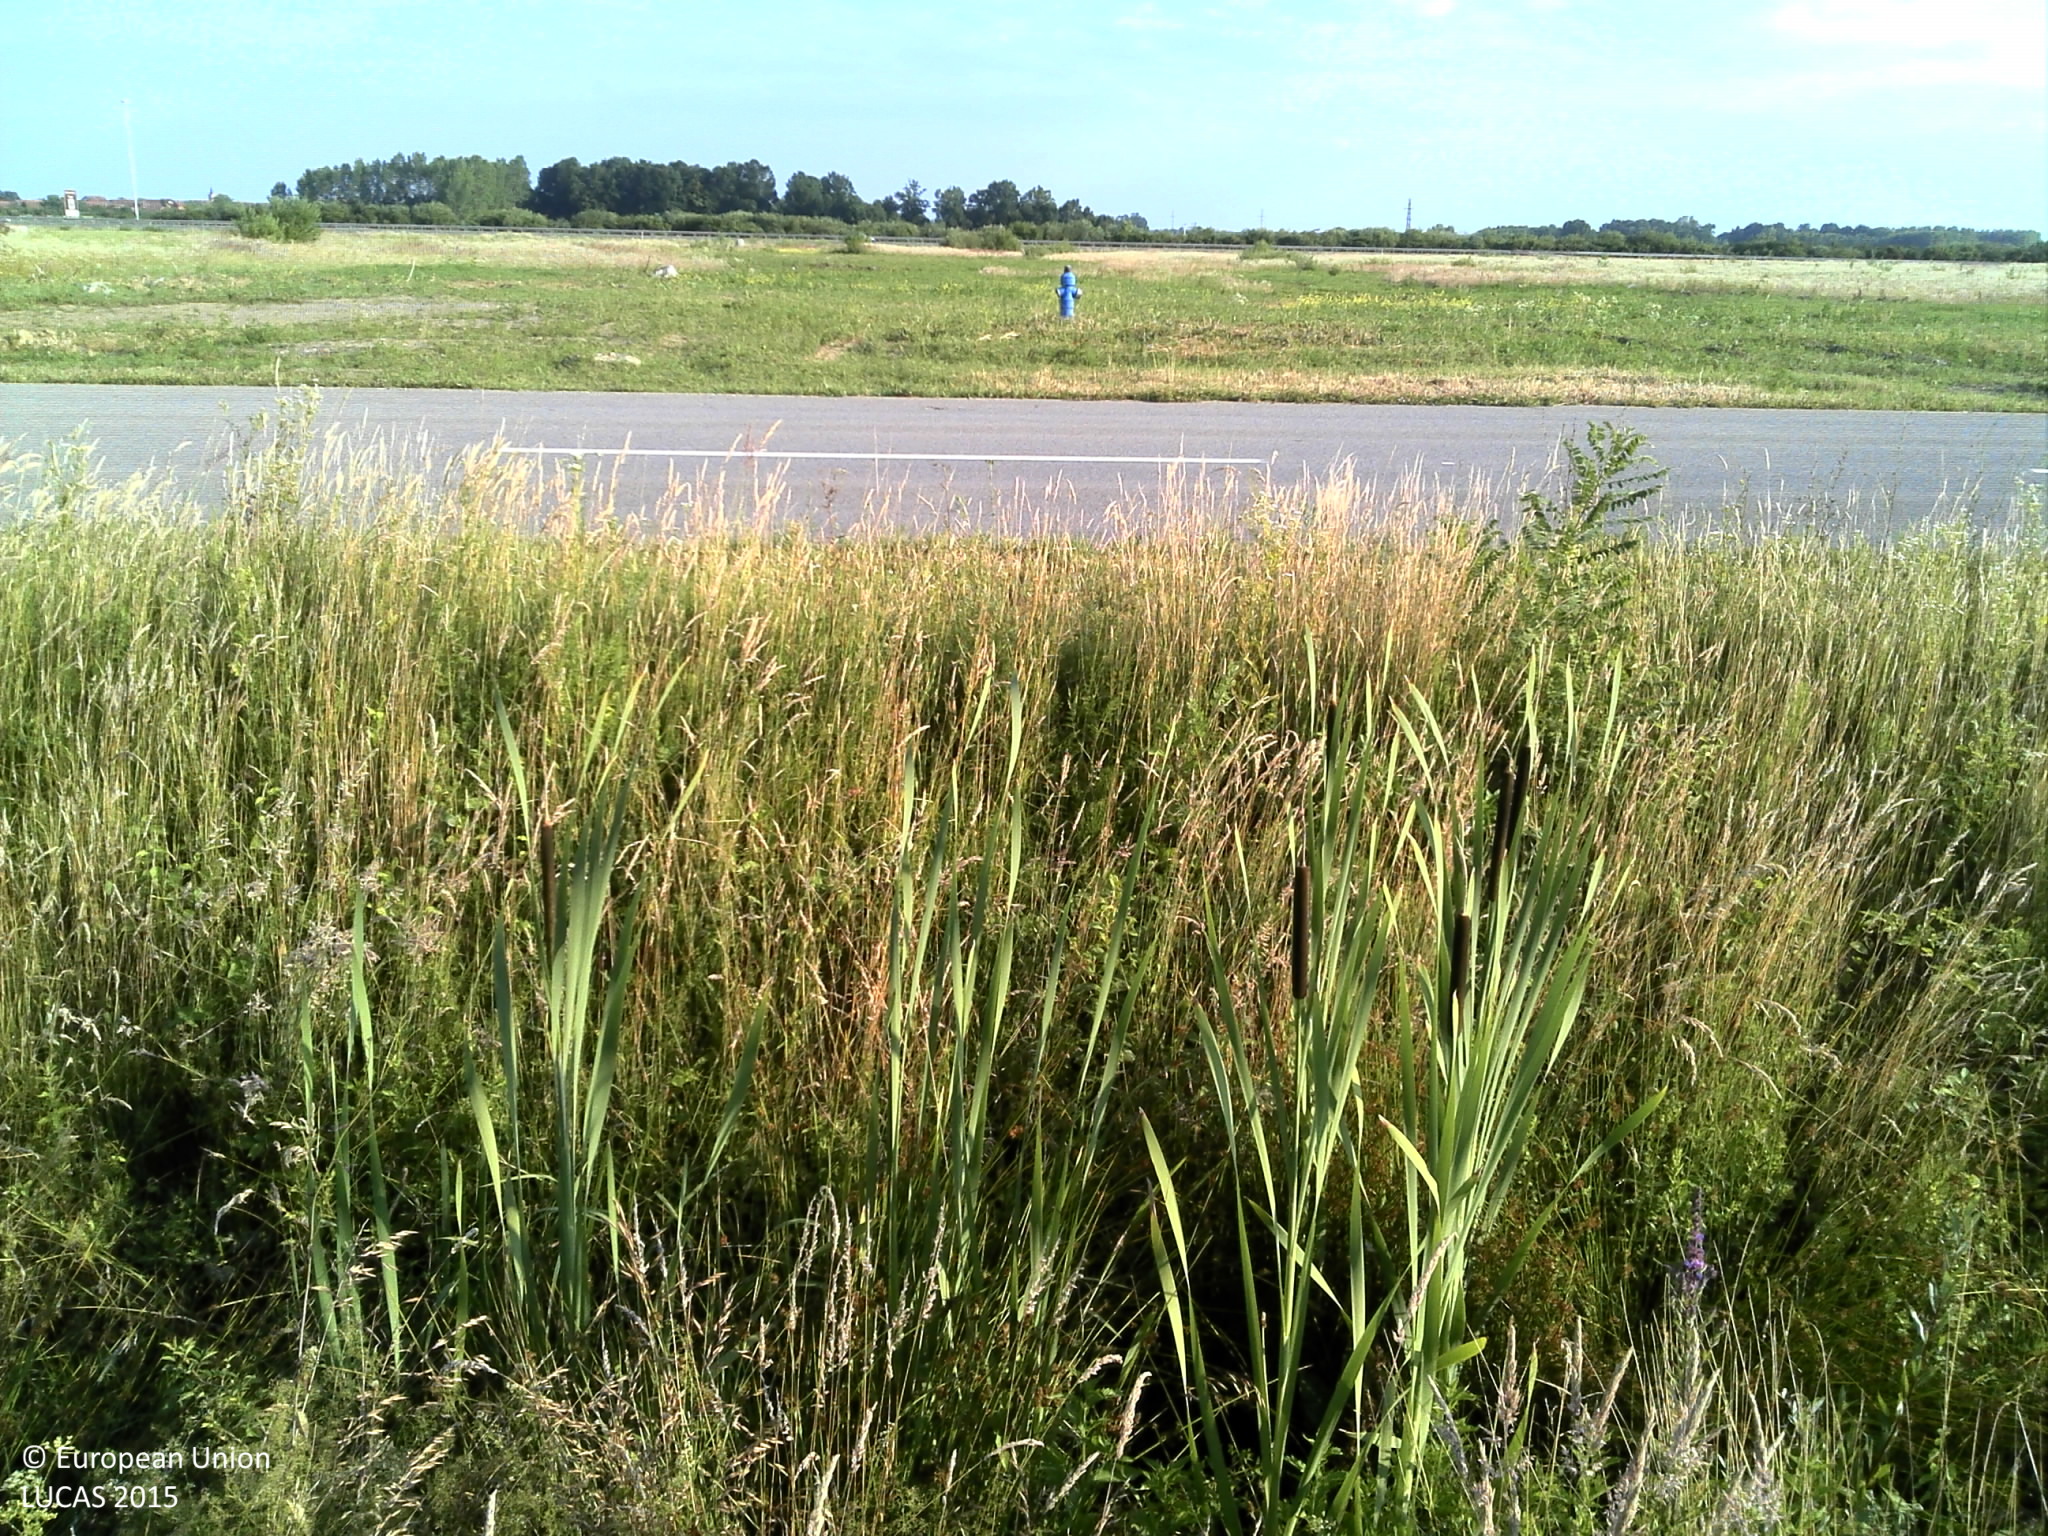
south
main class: Cropland
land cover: Soya
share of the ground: 25 - 50 %
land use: Agriculture (excluding fallow land and kitchen gardens)
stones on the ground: < 10 %
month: June
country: HR
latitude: 45.2282
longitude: 17.3744
